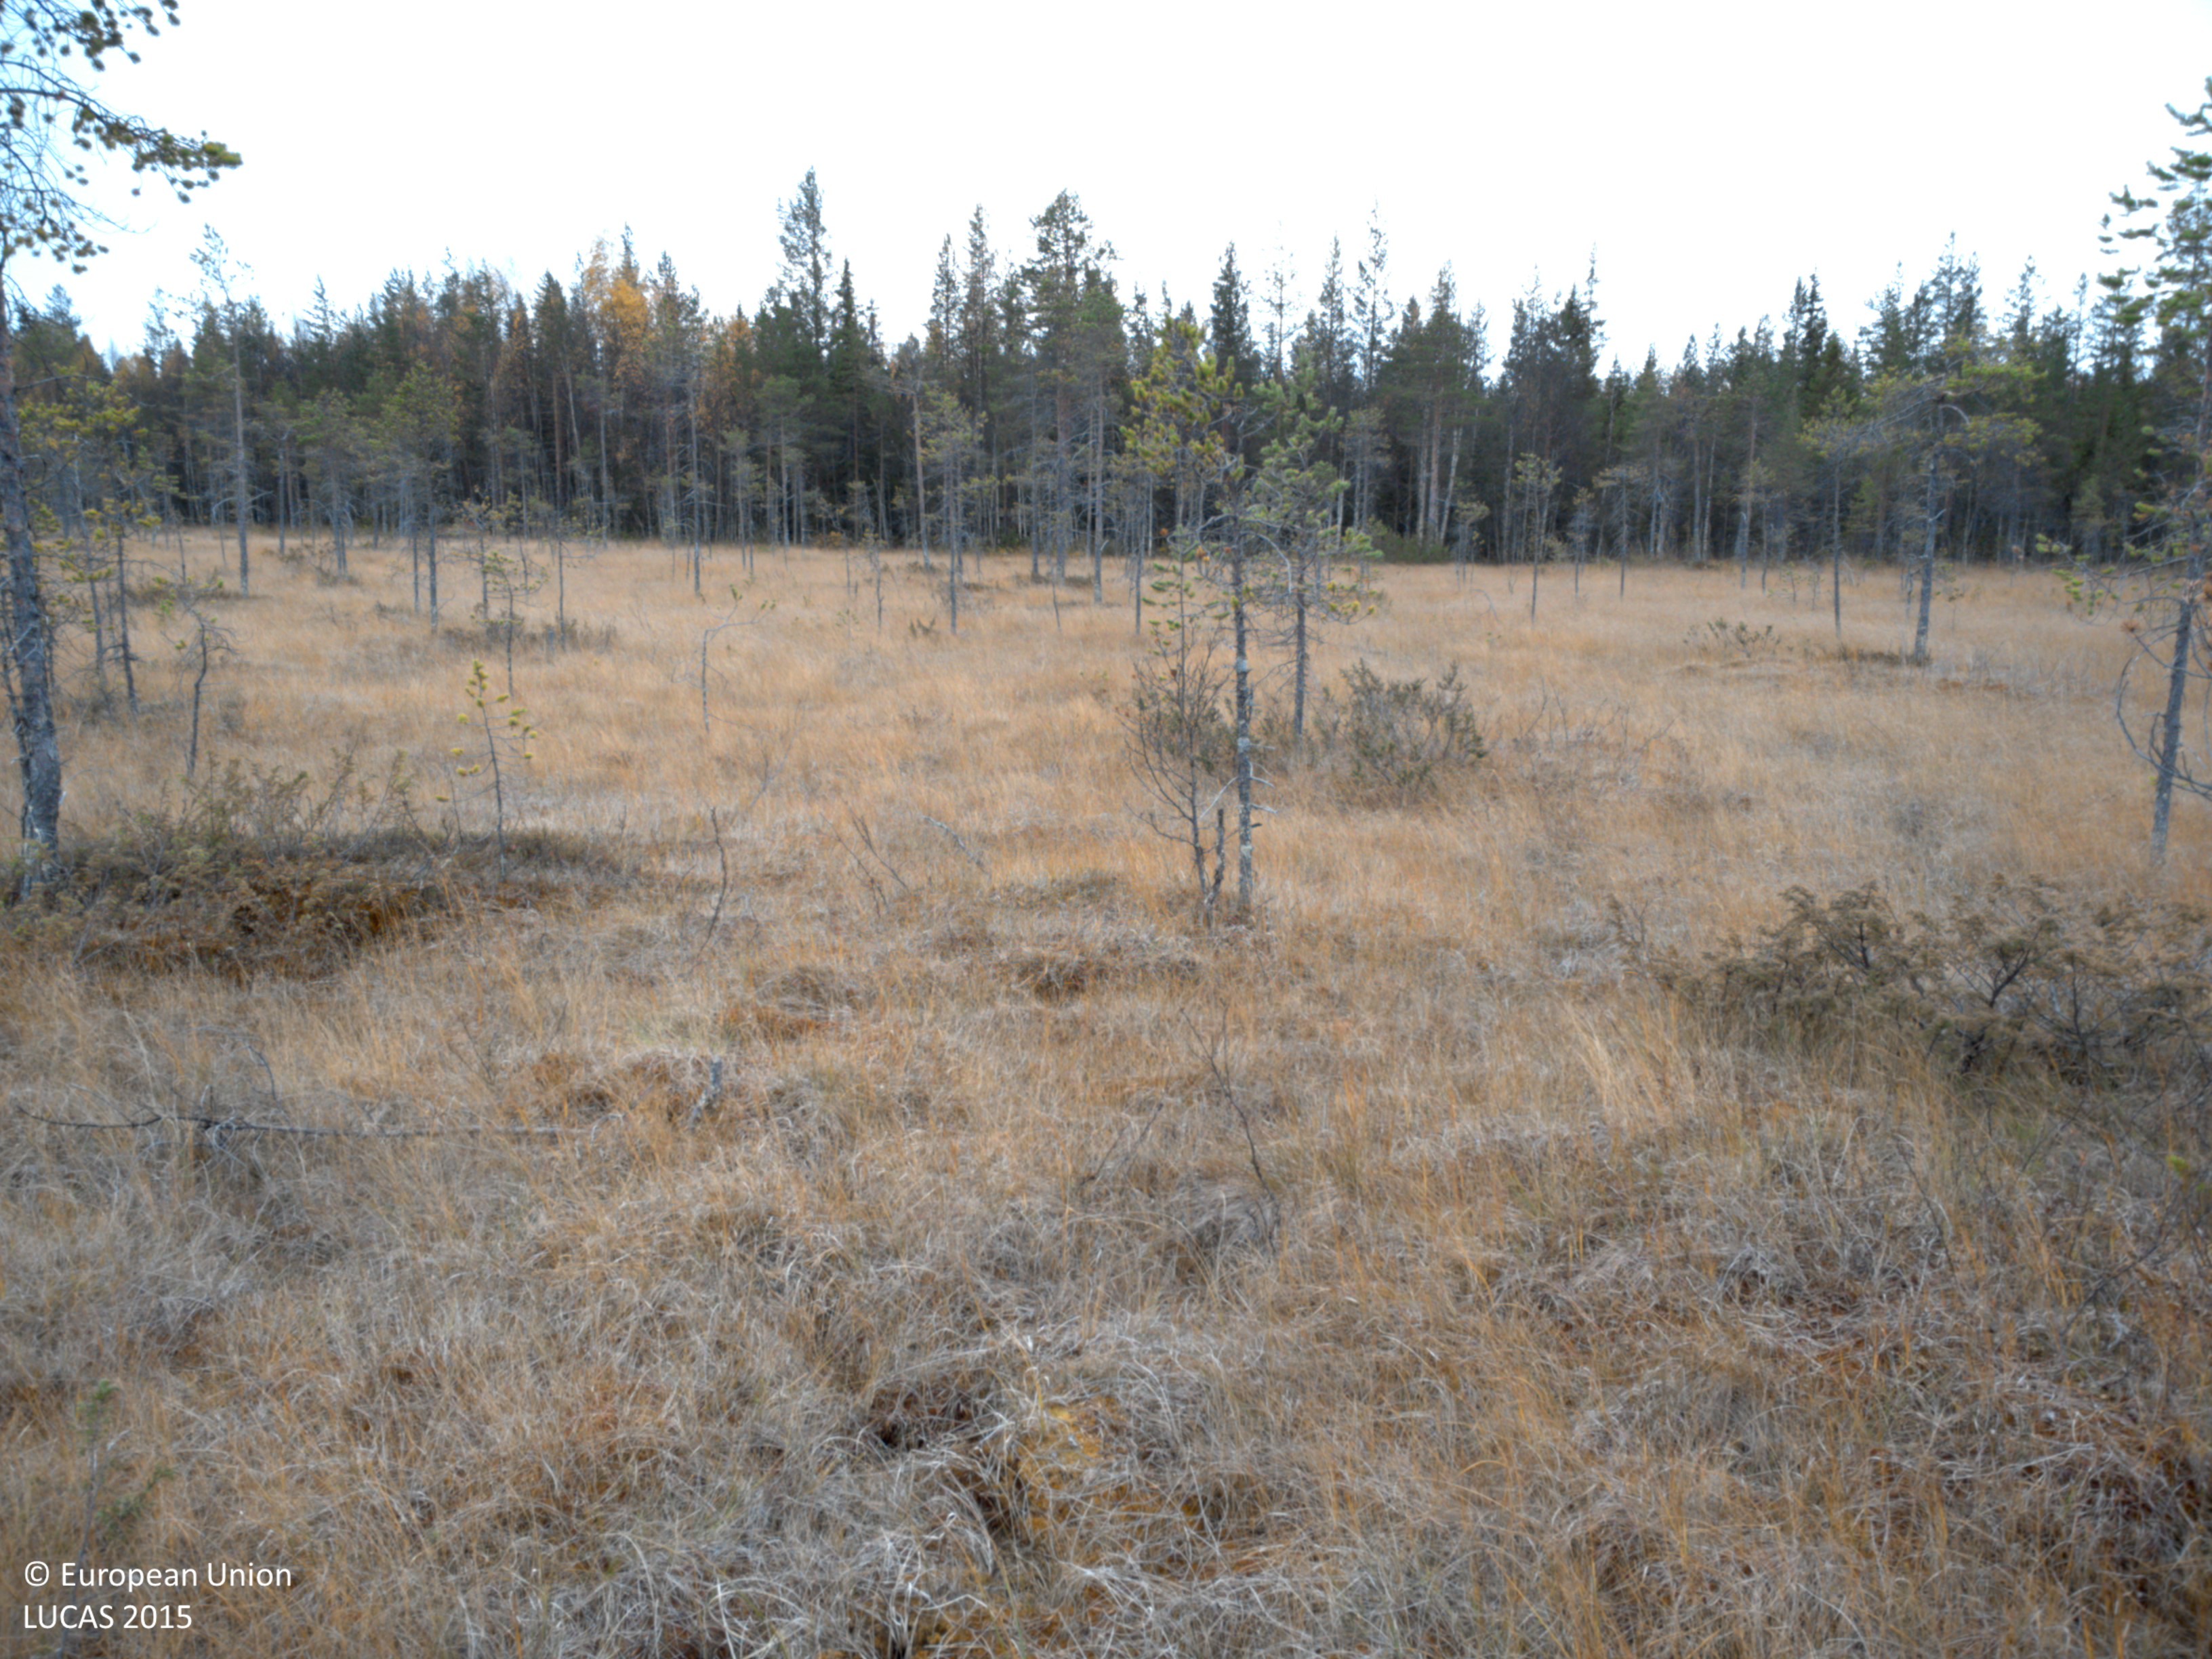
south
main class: Woodland
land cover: Pine dominated coniferous woodland
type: boreal forest
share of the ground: 10 - 25 %
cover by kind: herbaceous plants 45 %, shrubs 25 %, coniferous forest trees 15 %, lichens and mosses 15 %
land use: Semi-natural and natural areas not in use
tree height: < 5 m
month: October
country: SE
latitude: 65.0211
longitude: 18.2196
